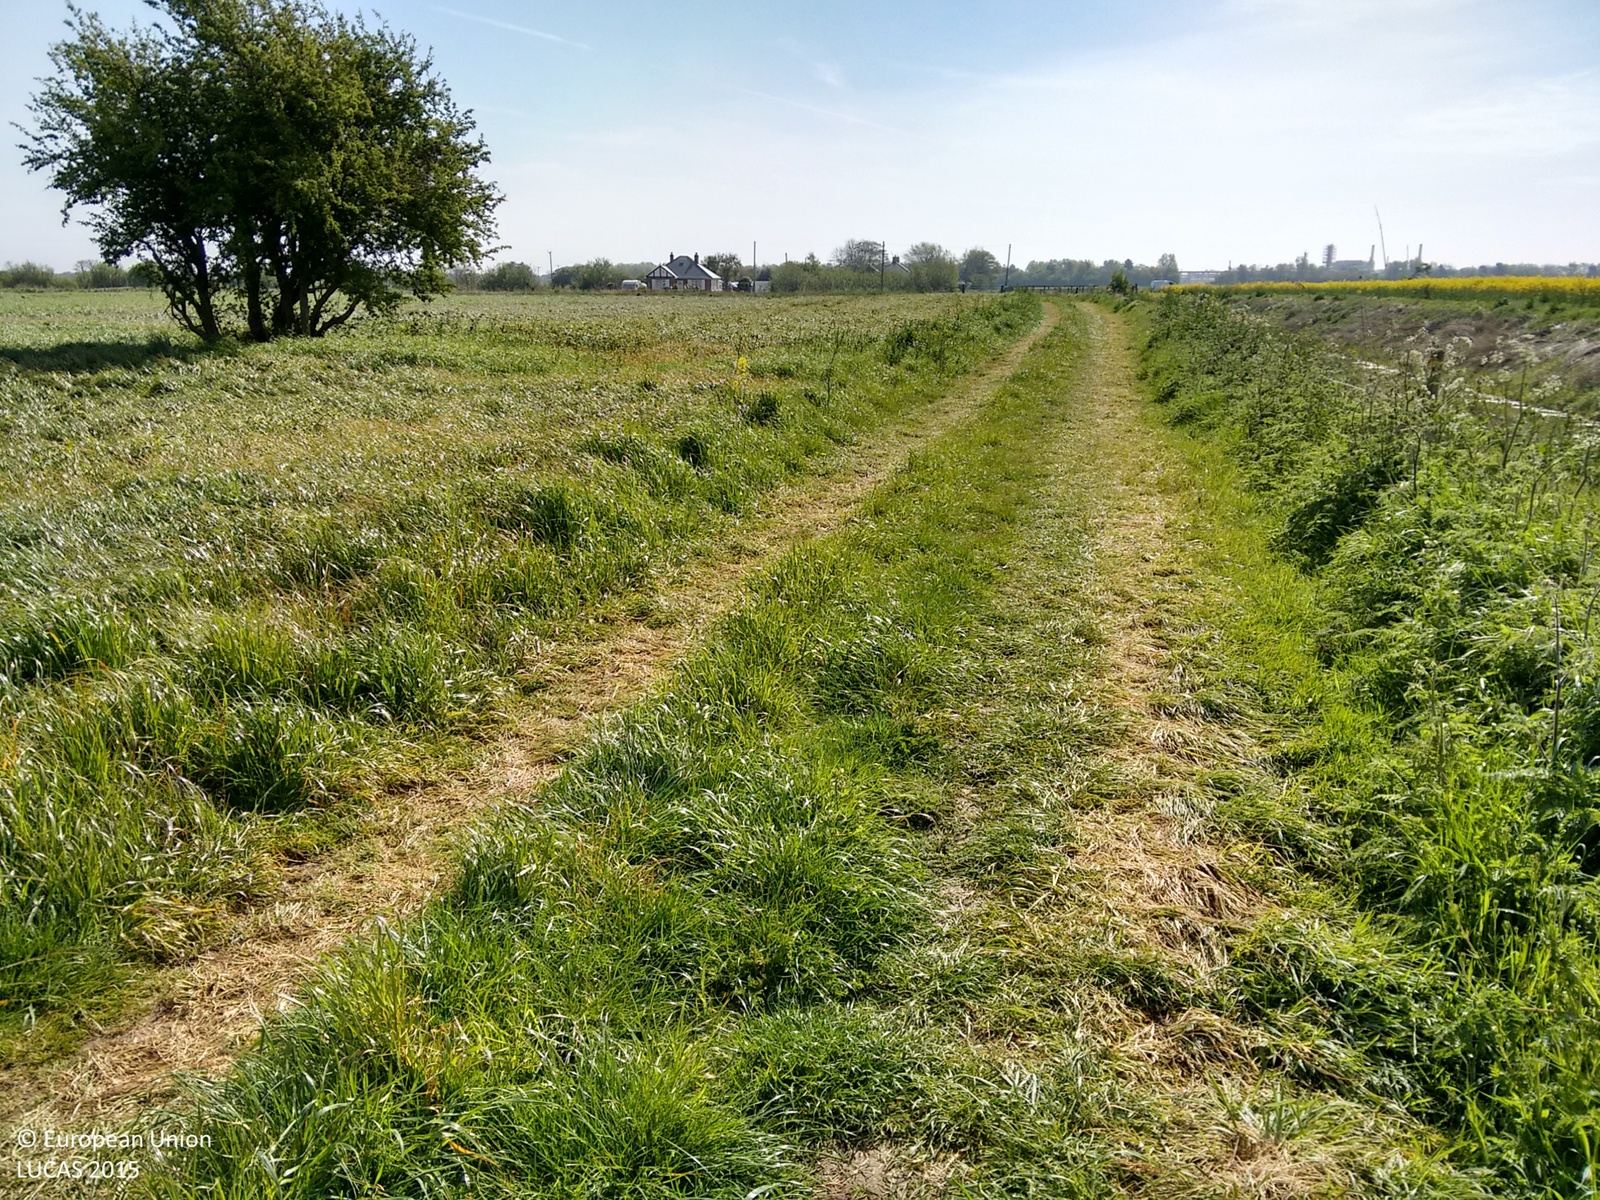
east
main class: Cropland
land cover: Rape and turnip rape
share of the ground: > 75 %
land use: Agriculture (excluding fallow land and kitchen gardens)
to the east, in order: Rape and turnip rape; Grass margins; Rivers and streams; Grass margins; Fences; Tracks; Grassland without tree/shrub cover; Fences; Grass margins; Ditches and canals; Grass margins; Paved roads, cycling and walking lanes; Electric lines; Paved roads, cycling and walking lanes; Grass margins; Ditches and canals; Artificial constructions in urban areas
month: May
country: GB
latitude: 53.3672
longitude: 0.2169
